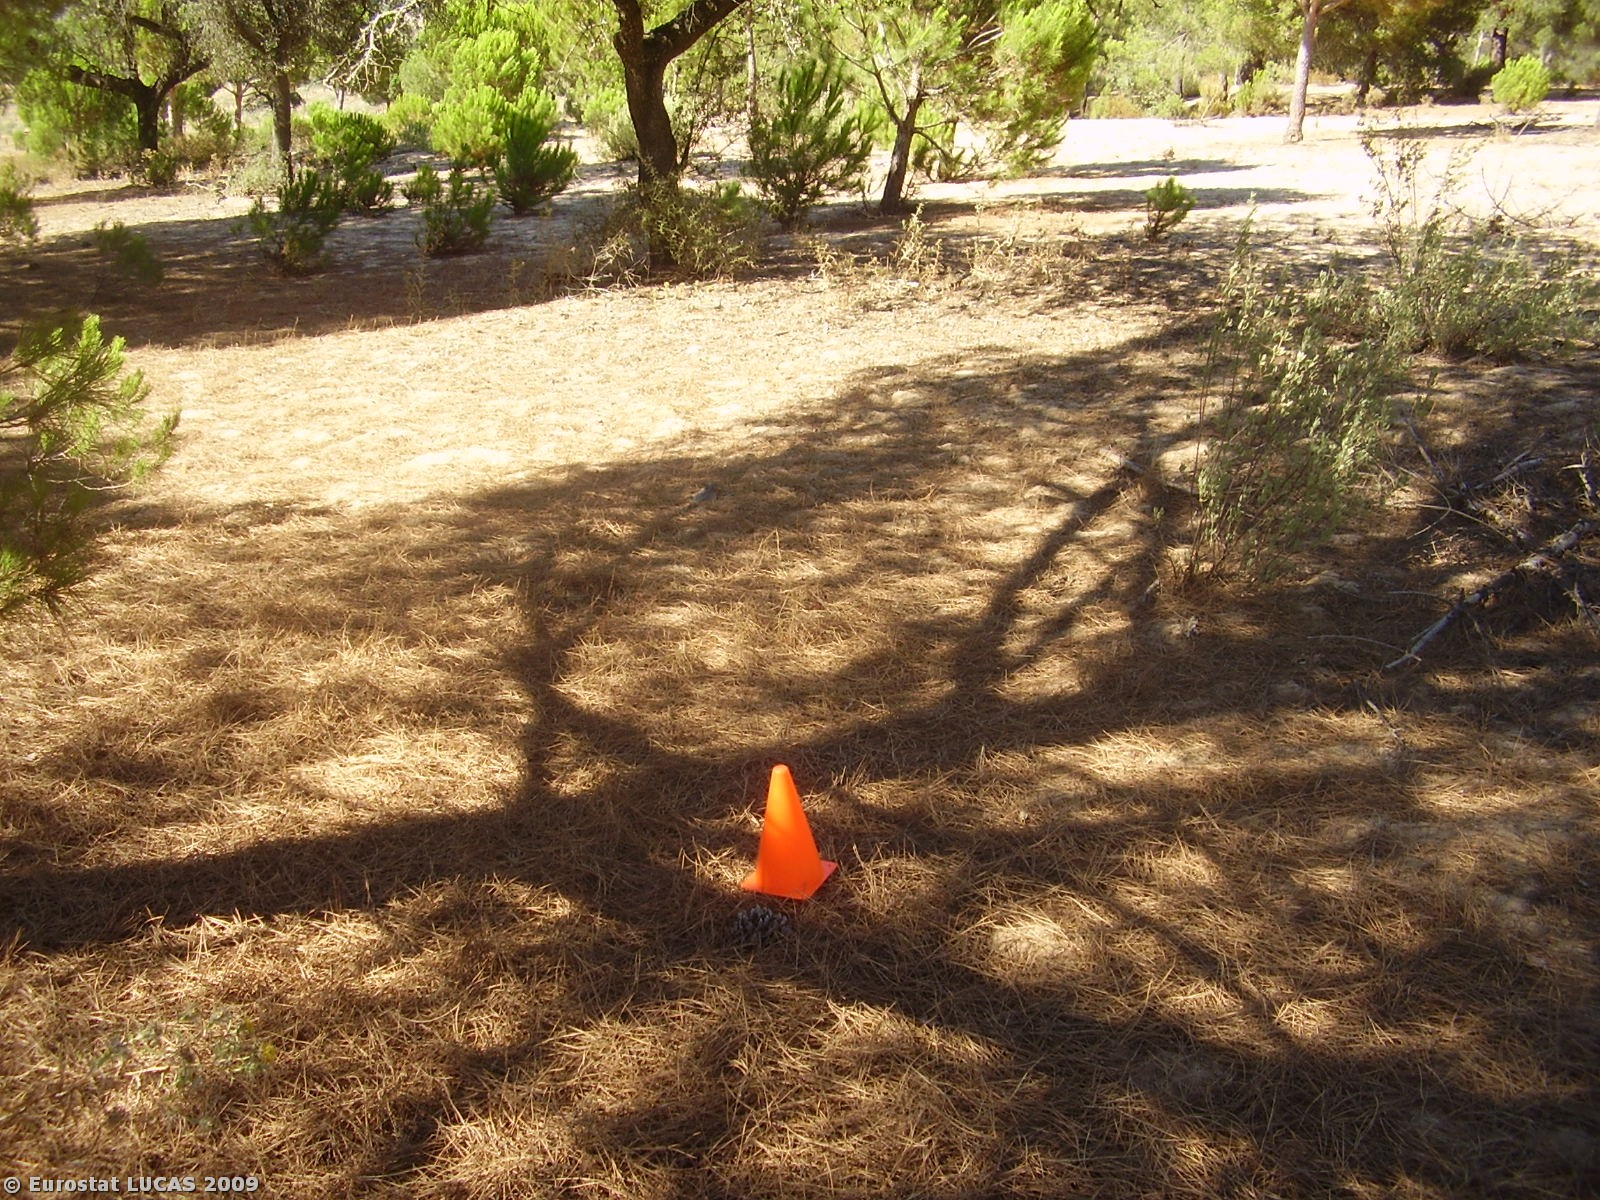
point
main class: Woodland
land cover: Coniferous woodland
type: coniferous forest of the mediterranean region
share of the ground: 25 - 50 %
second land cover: Spontaneously vegetated surfaces
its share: 10 - 25 %
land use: Forestry
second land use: Fallow land
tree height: > 5 m
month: July
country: PT
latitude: 38.1131
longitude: -8.3473
